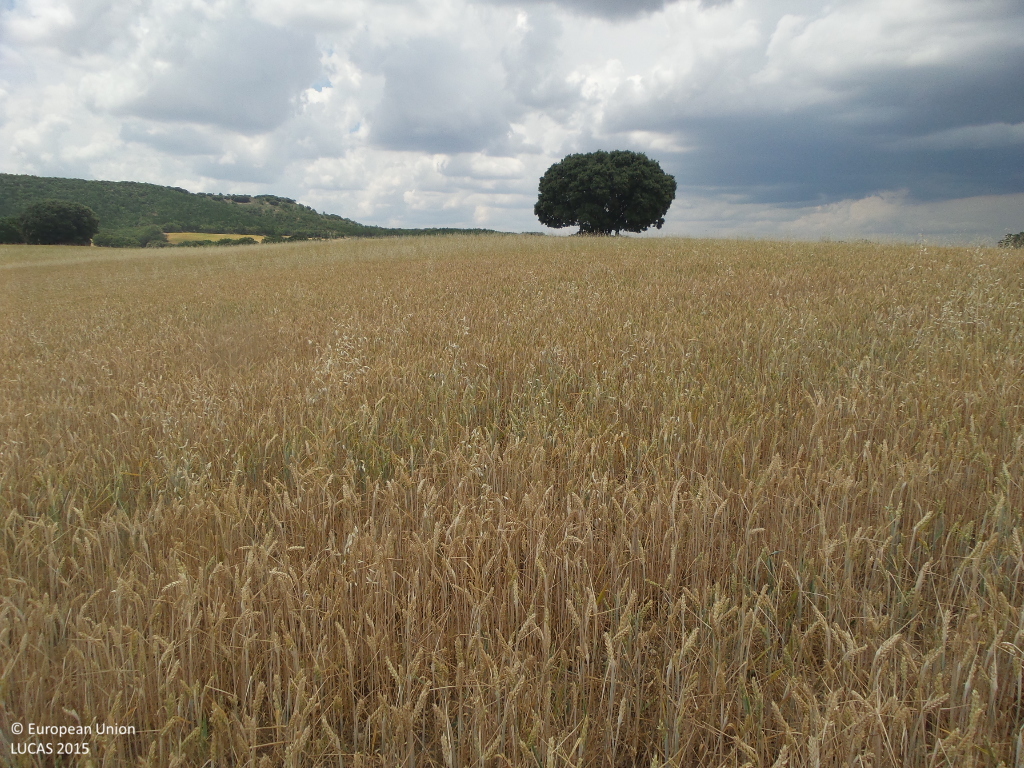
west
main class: Cropland
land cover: Common wheat
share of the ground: > 75 %
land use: Agriculture (excluding fallow land and kitchen gardens)
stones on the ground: < 10 %
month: June
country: ES
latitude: 41.4445
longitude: -2.7370
